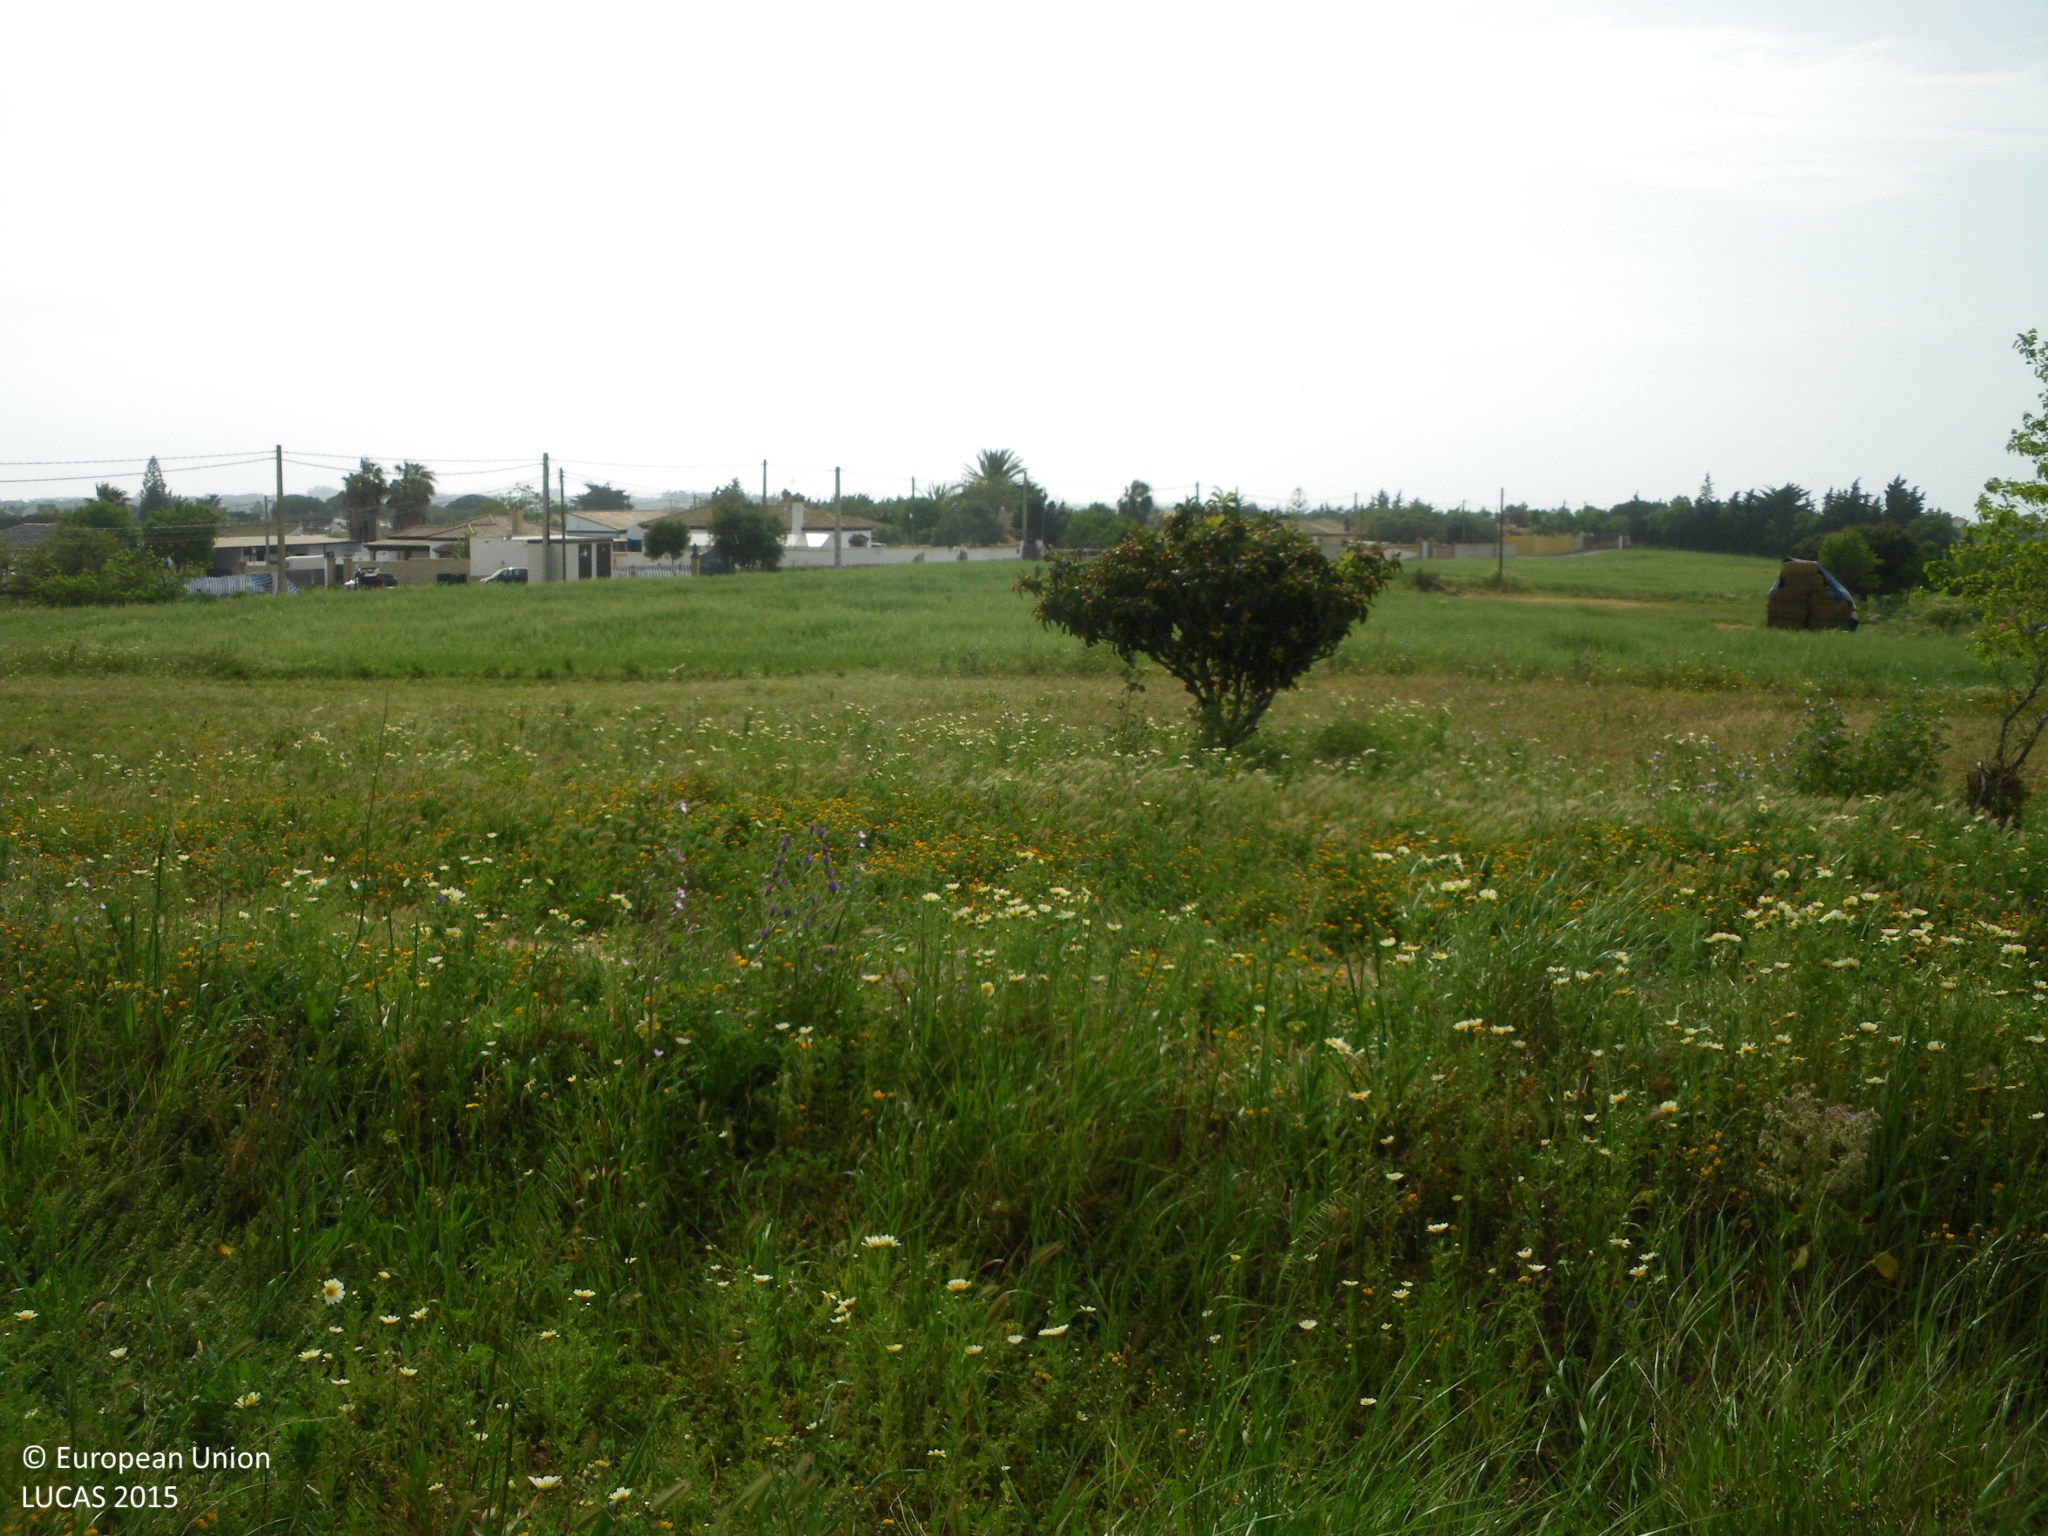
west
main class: Grassland
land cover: Grassland with sparse tree/shrub cover
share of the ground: > 75 %
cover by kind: herbaceous plants 90 %, broadleaved forest trees 5 %, shrubs 5 %
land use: Abandoned areas
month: April
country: ES
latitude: 36.3959
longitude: -6.1396
